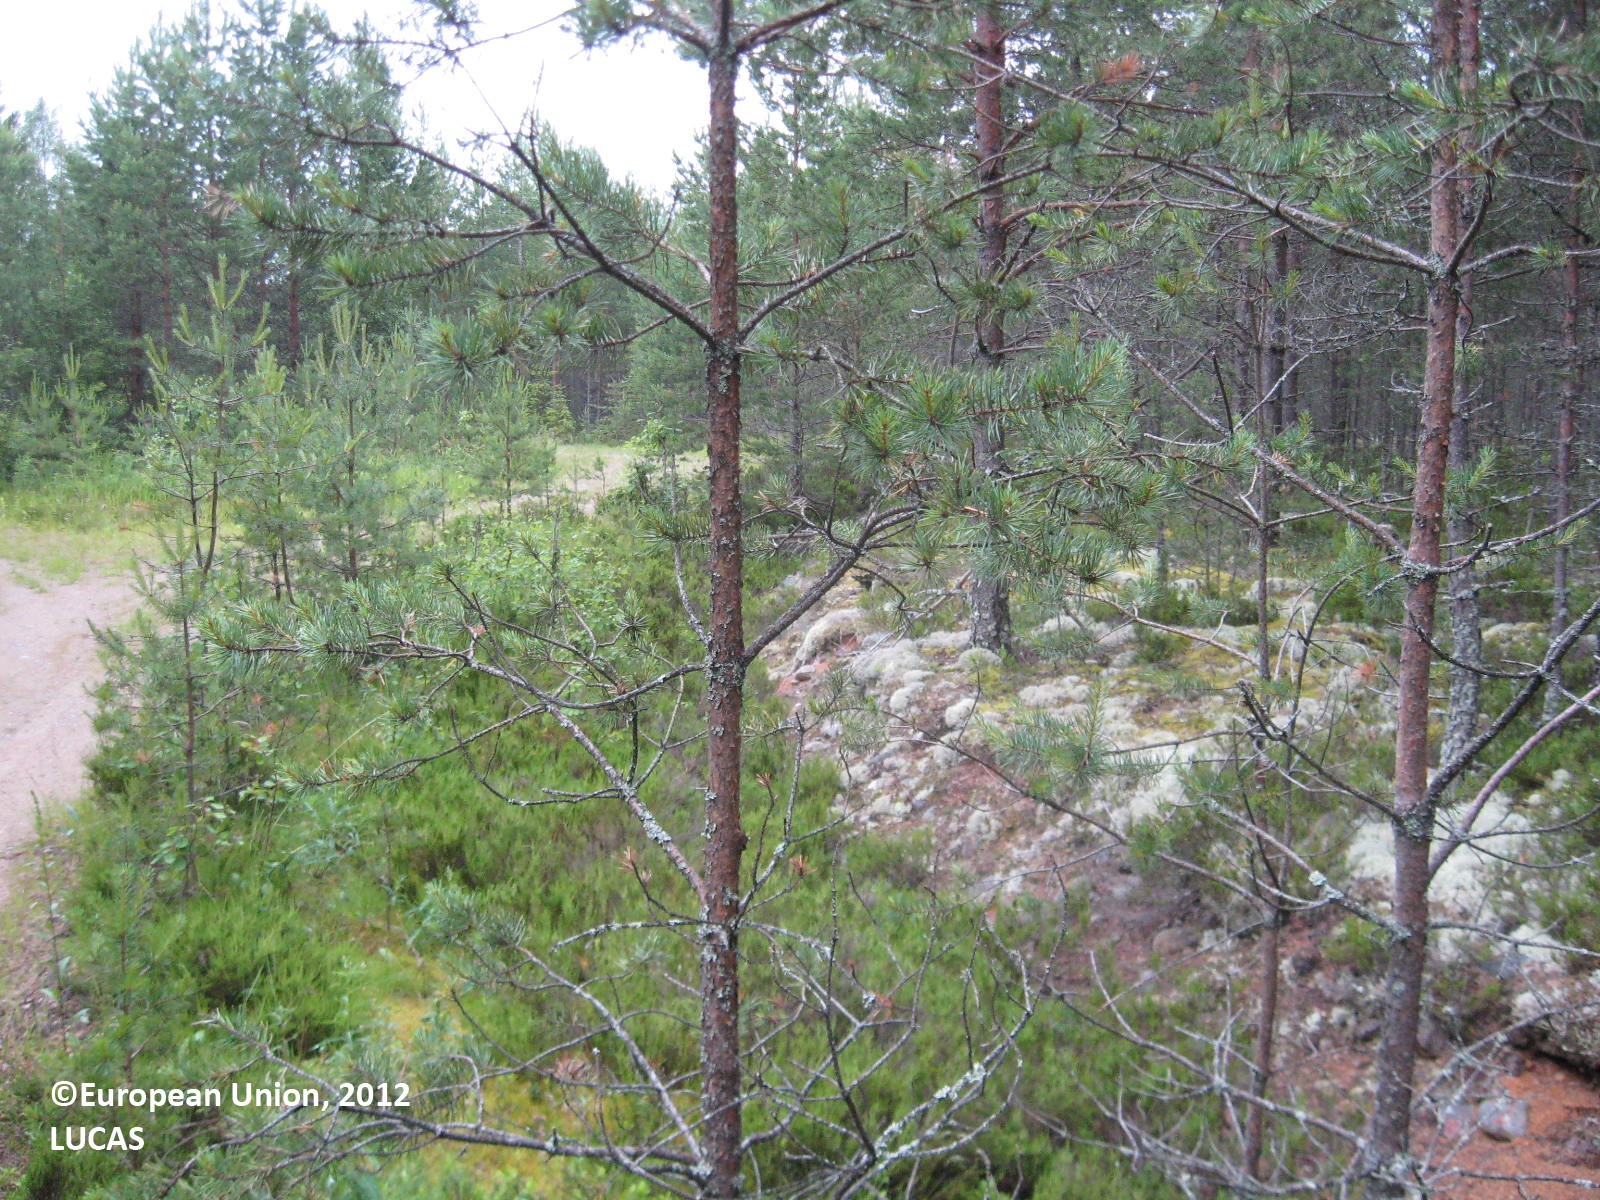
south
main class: Woodland
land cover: Pine dominated coniferous woodland
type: boreal forest
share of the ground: > 75 %
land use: Forestry
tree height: > 5 m
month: July
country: FI
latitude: 62.3473
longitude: 22.4755
